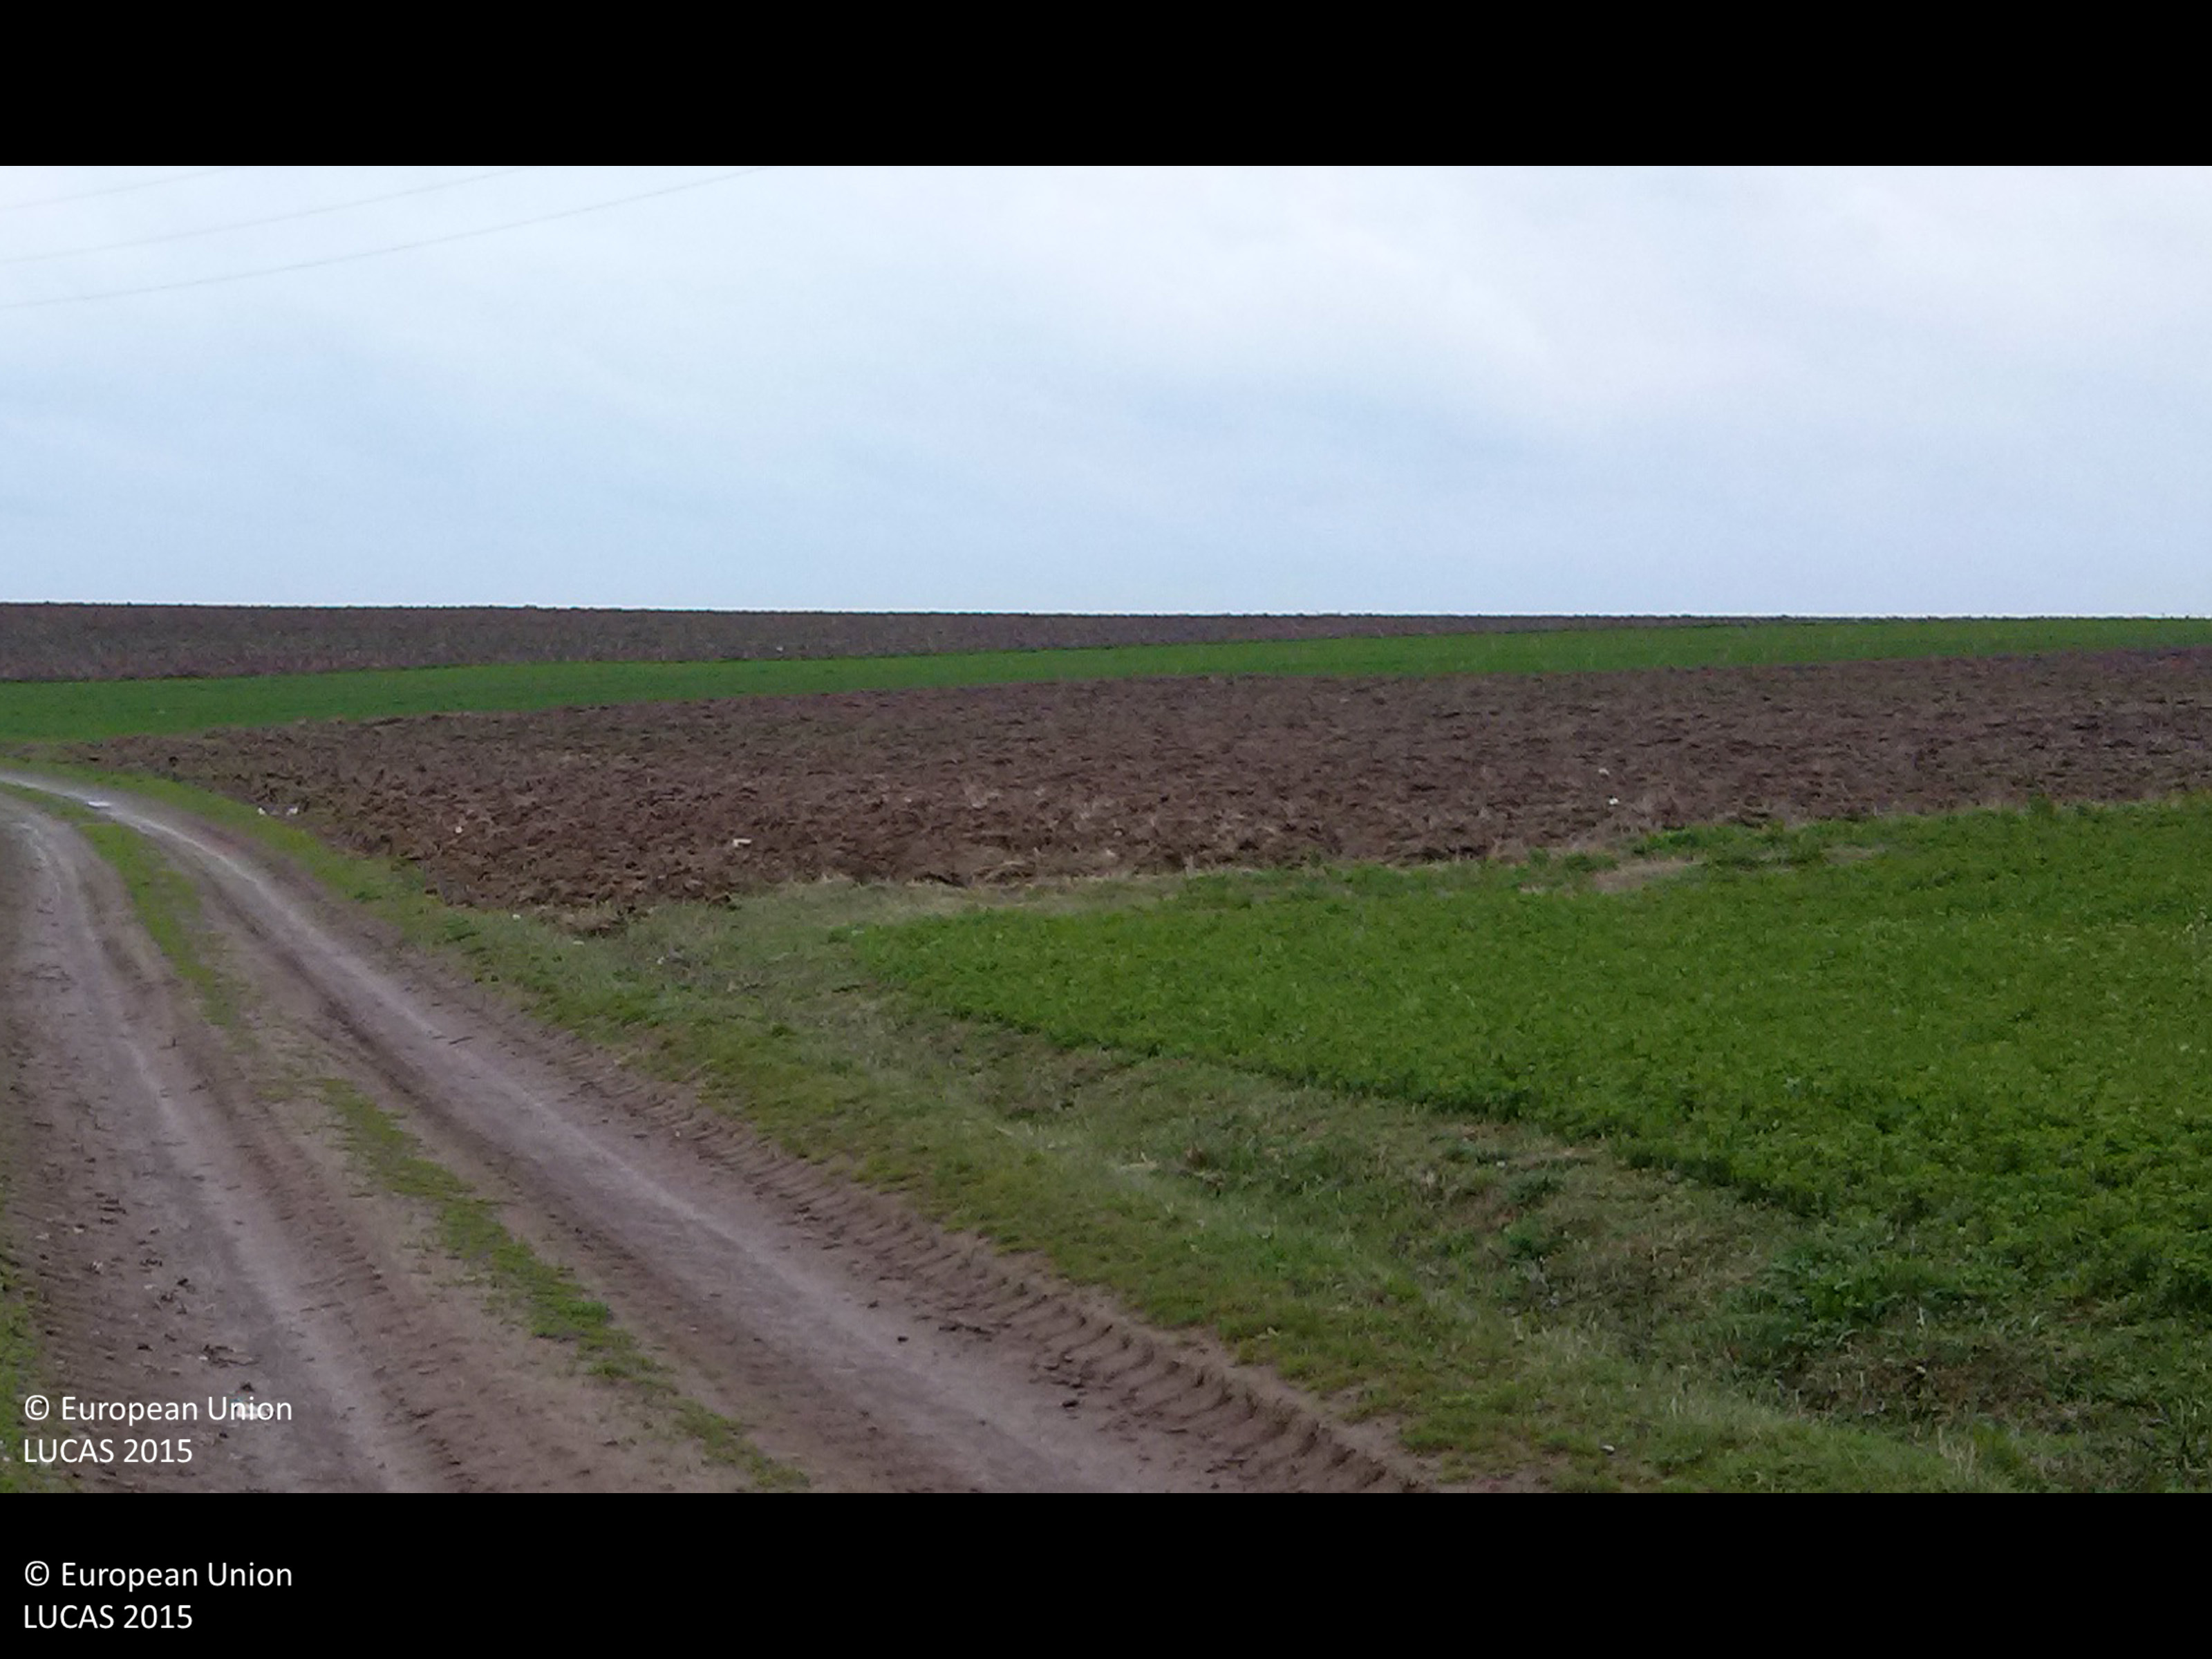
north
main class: Cropland
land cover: Common wheat
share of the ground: > 75 %
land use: Agriculture (excluding fallow land and kitchen gardens)
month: June
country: BG
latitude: 43.6552
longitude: 26.7654
